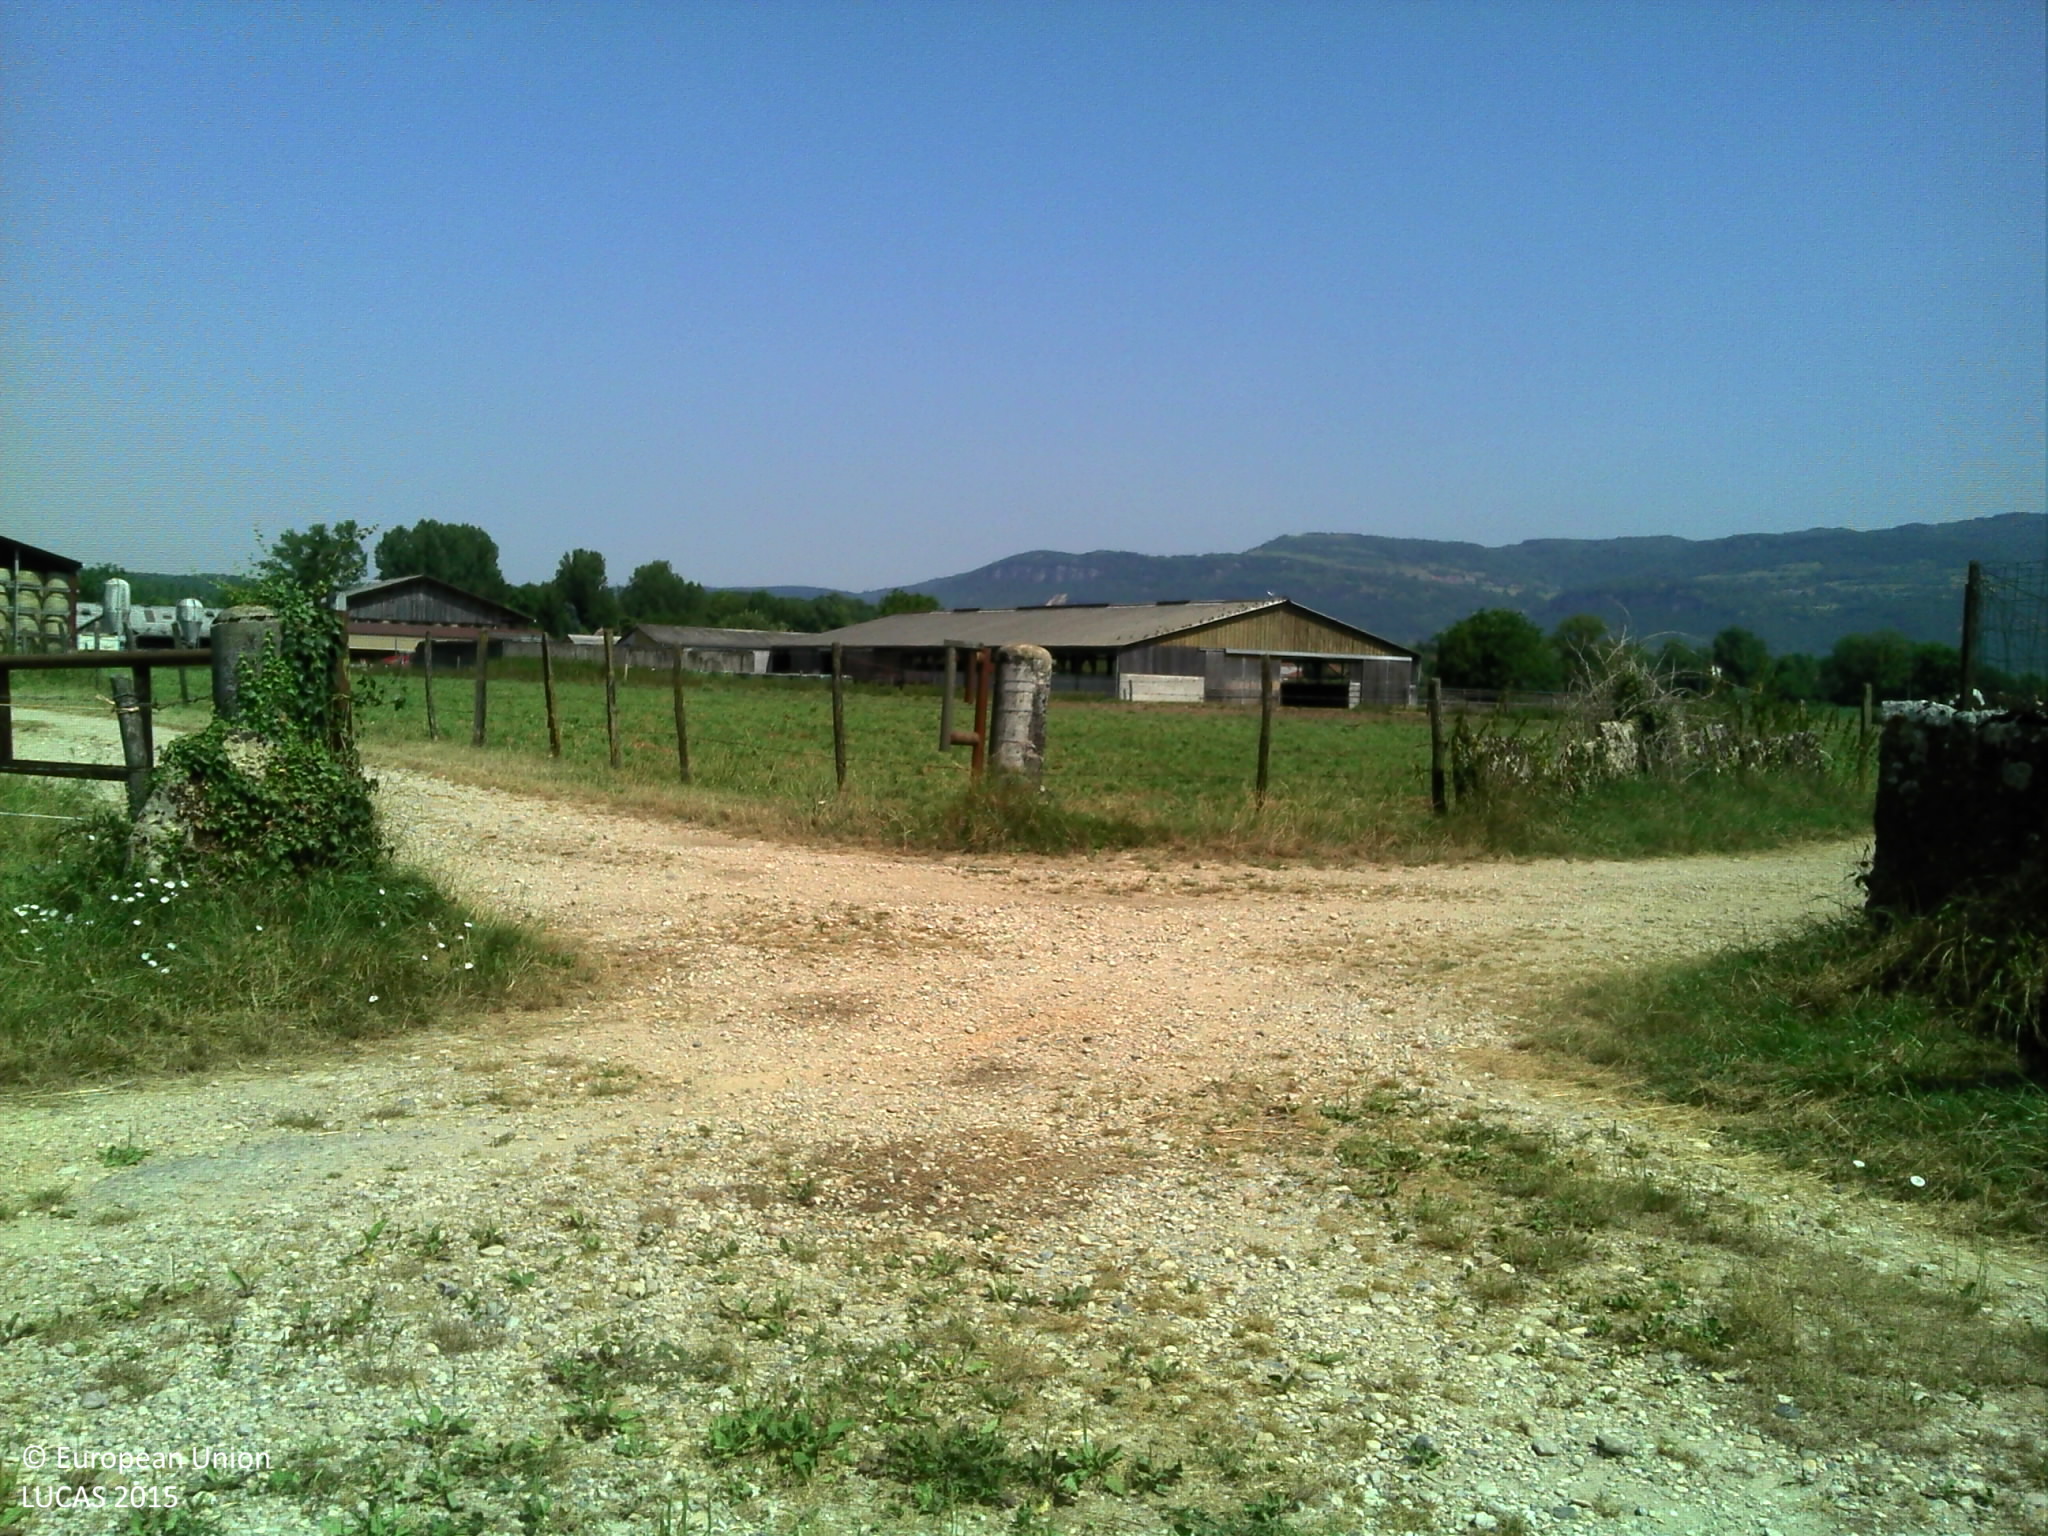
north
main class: Grassland
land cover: Grassland without tree/shrub cover
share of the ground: > 75 %
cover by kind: herbaceous plants 100 %
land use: Agriculture (excluding fallow land and kitchen gardens)
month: July
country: FR
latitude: 45.8197
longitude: 5.4091
